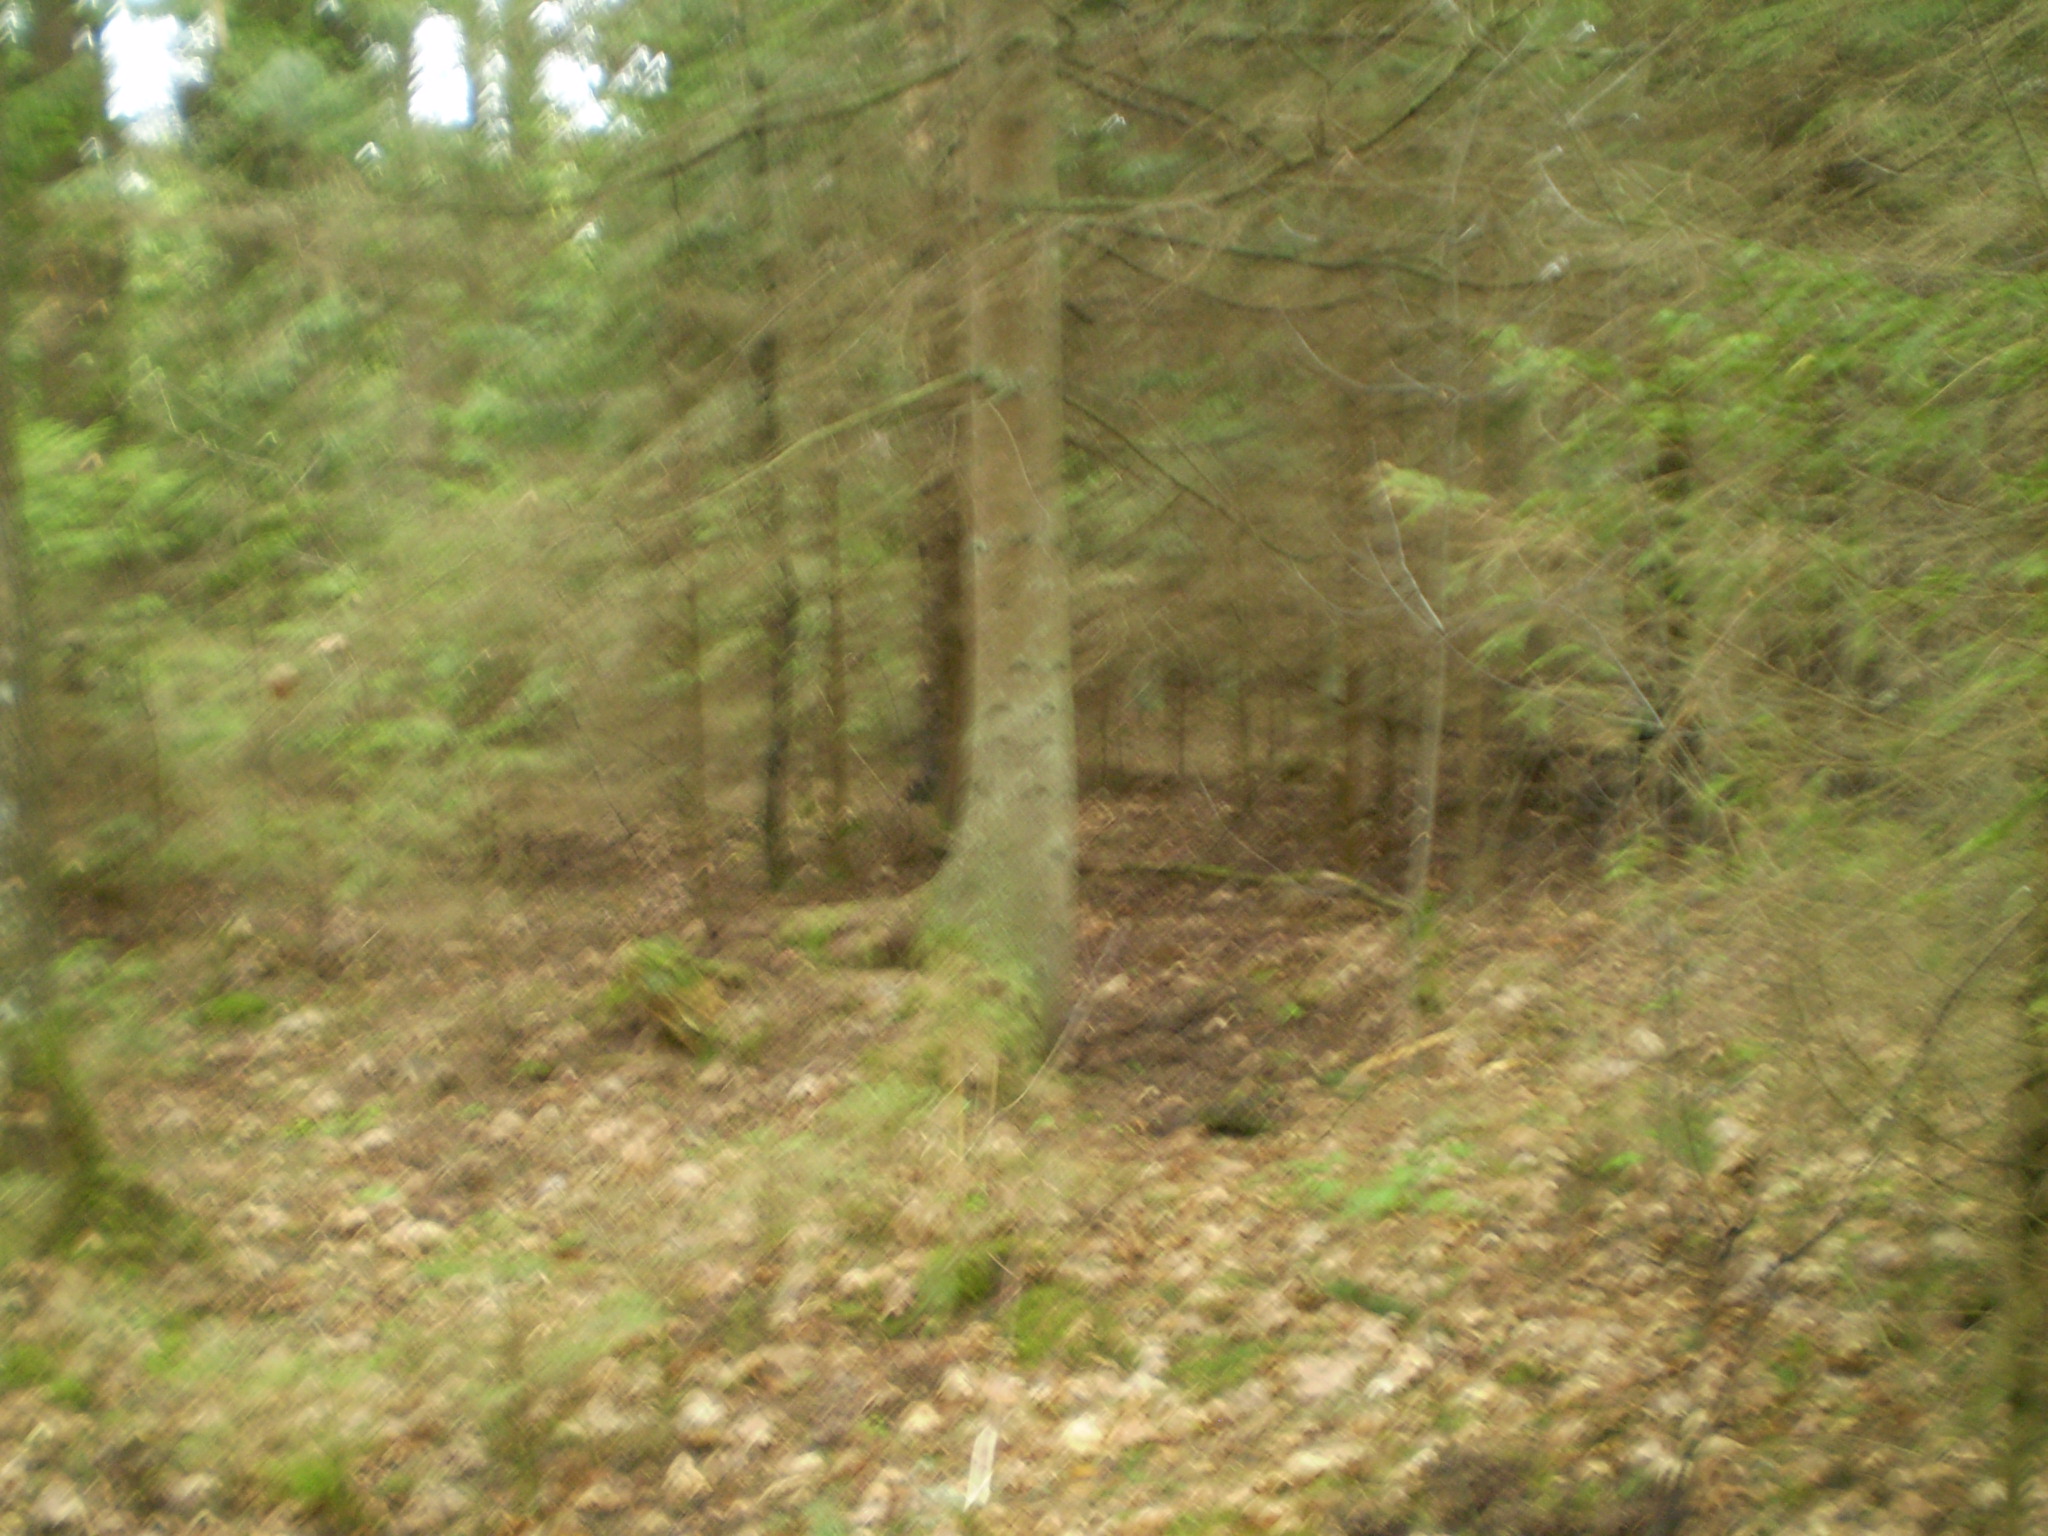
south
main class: Woodland
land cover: Spruce dominated coniferous woodland
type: hemiboreal forest and nemoral coniferous forest and mixed broadleaved-coniferous forest
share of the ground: > 75 %
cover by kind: coniferous forest trees 85 %, broadleaved forest trees 15 %
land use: Forestry
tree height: > 5 m
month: May
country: LT
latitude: 56.2874
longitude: 22.0870
